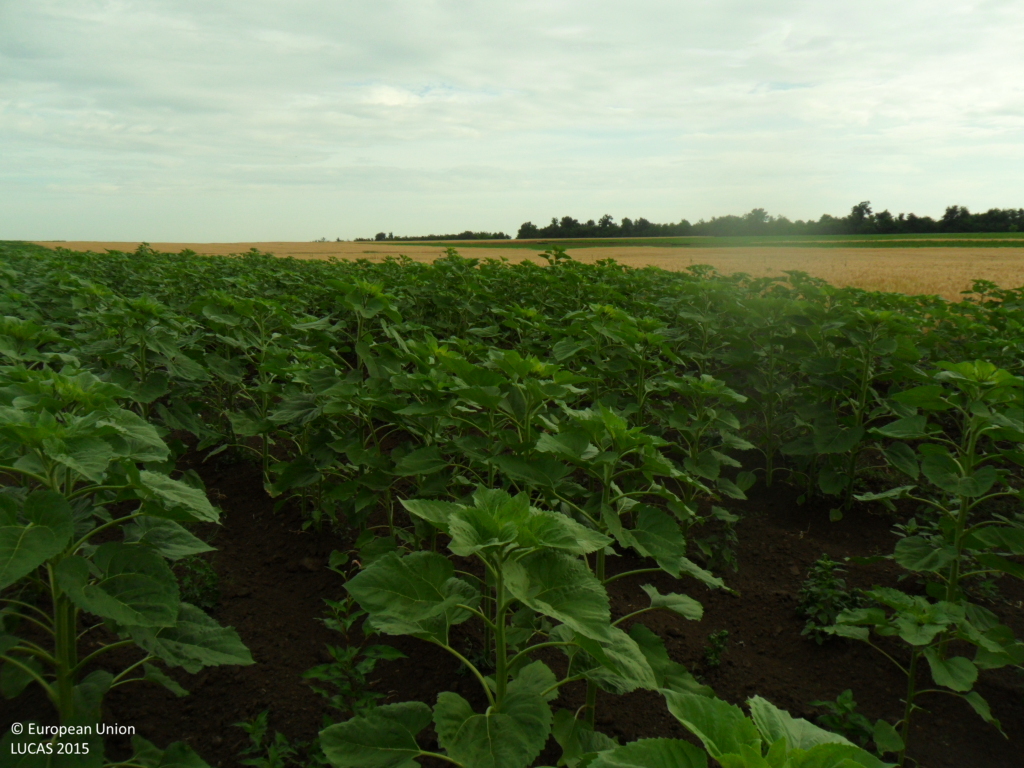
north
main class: Cropland
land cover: Sunflower
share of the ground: > 75 %
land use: Agriculture (excluding fallow land and kitchen gardens)
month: June
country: BG
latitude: 43.7362
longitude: 26.9424
